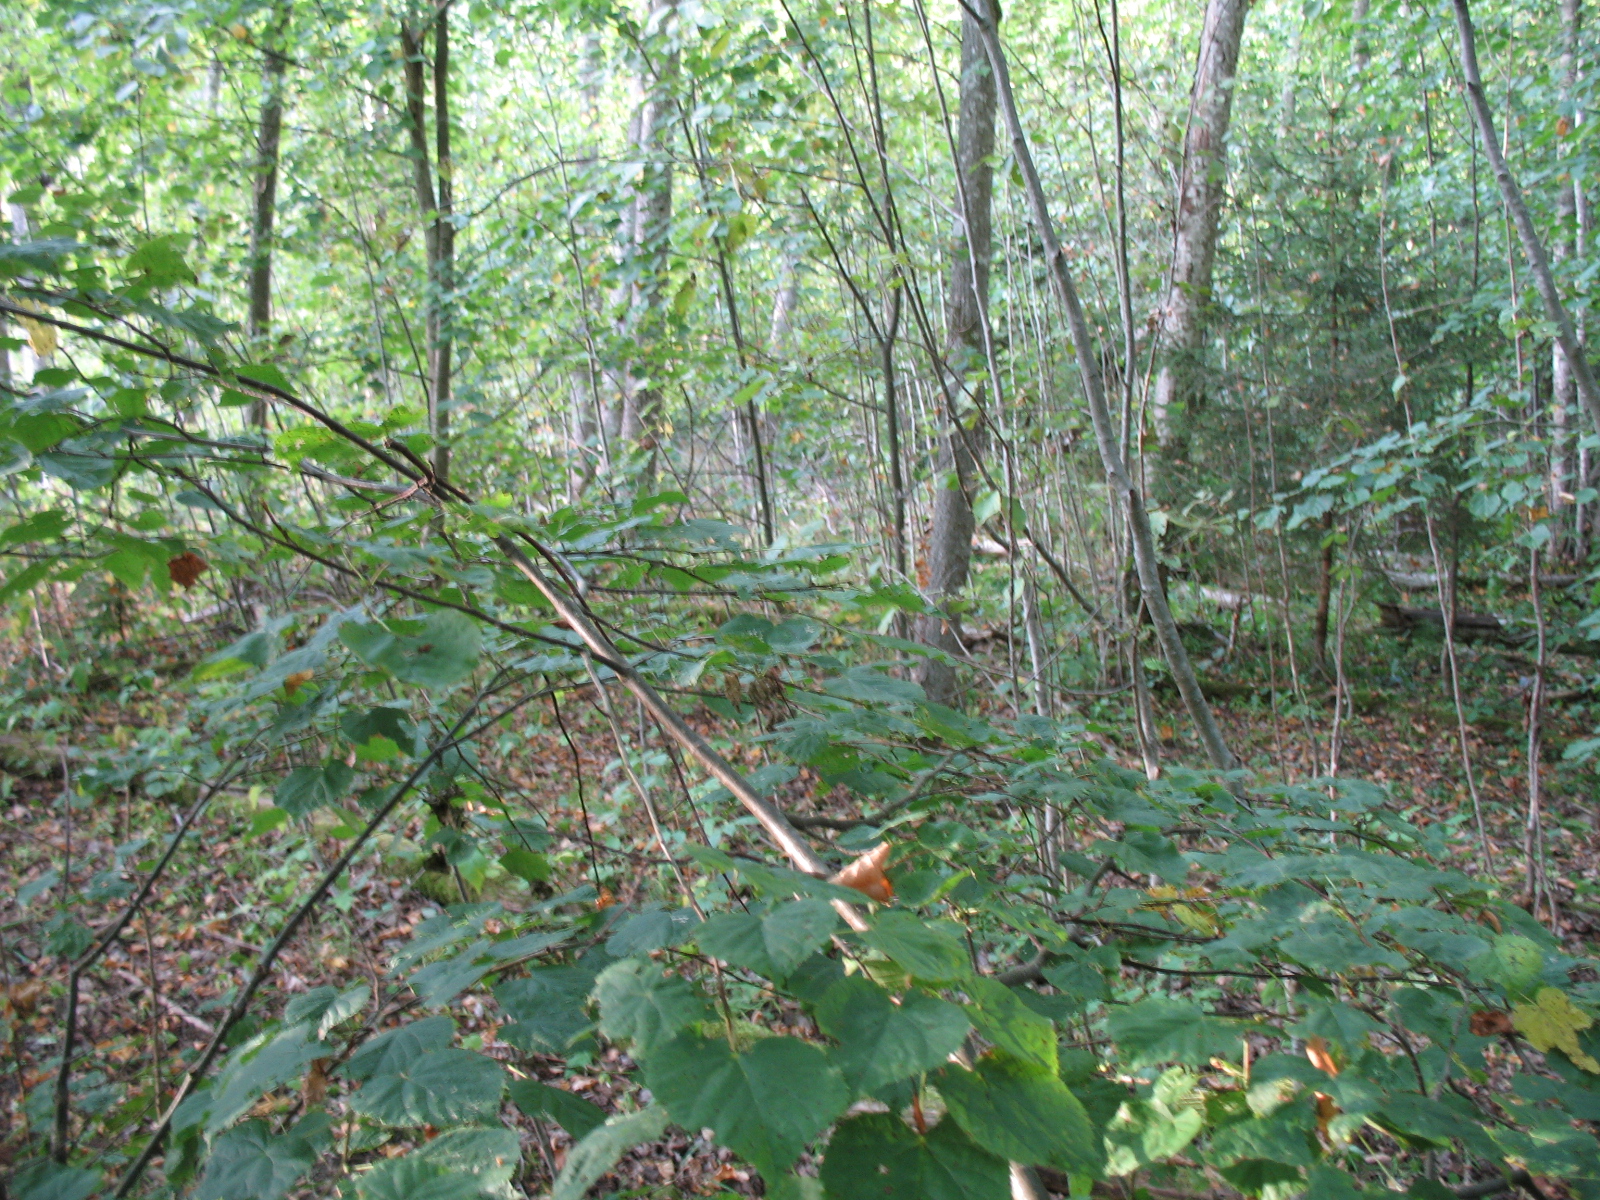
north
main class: Woodland
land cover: Broadleaved woodland
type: non-riverine alder, birch or aspen forest
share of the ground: > 75 %
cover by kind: broadleaved forest trees 85 %, herbaceous plants 15 %
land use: Forestry
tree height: > 5 m
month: August
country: LV
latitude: 56.3840
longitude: 26.0229
